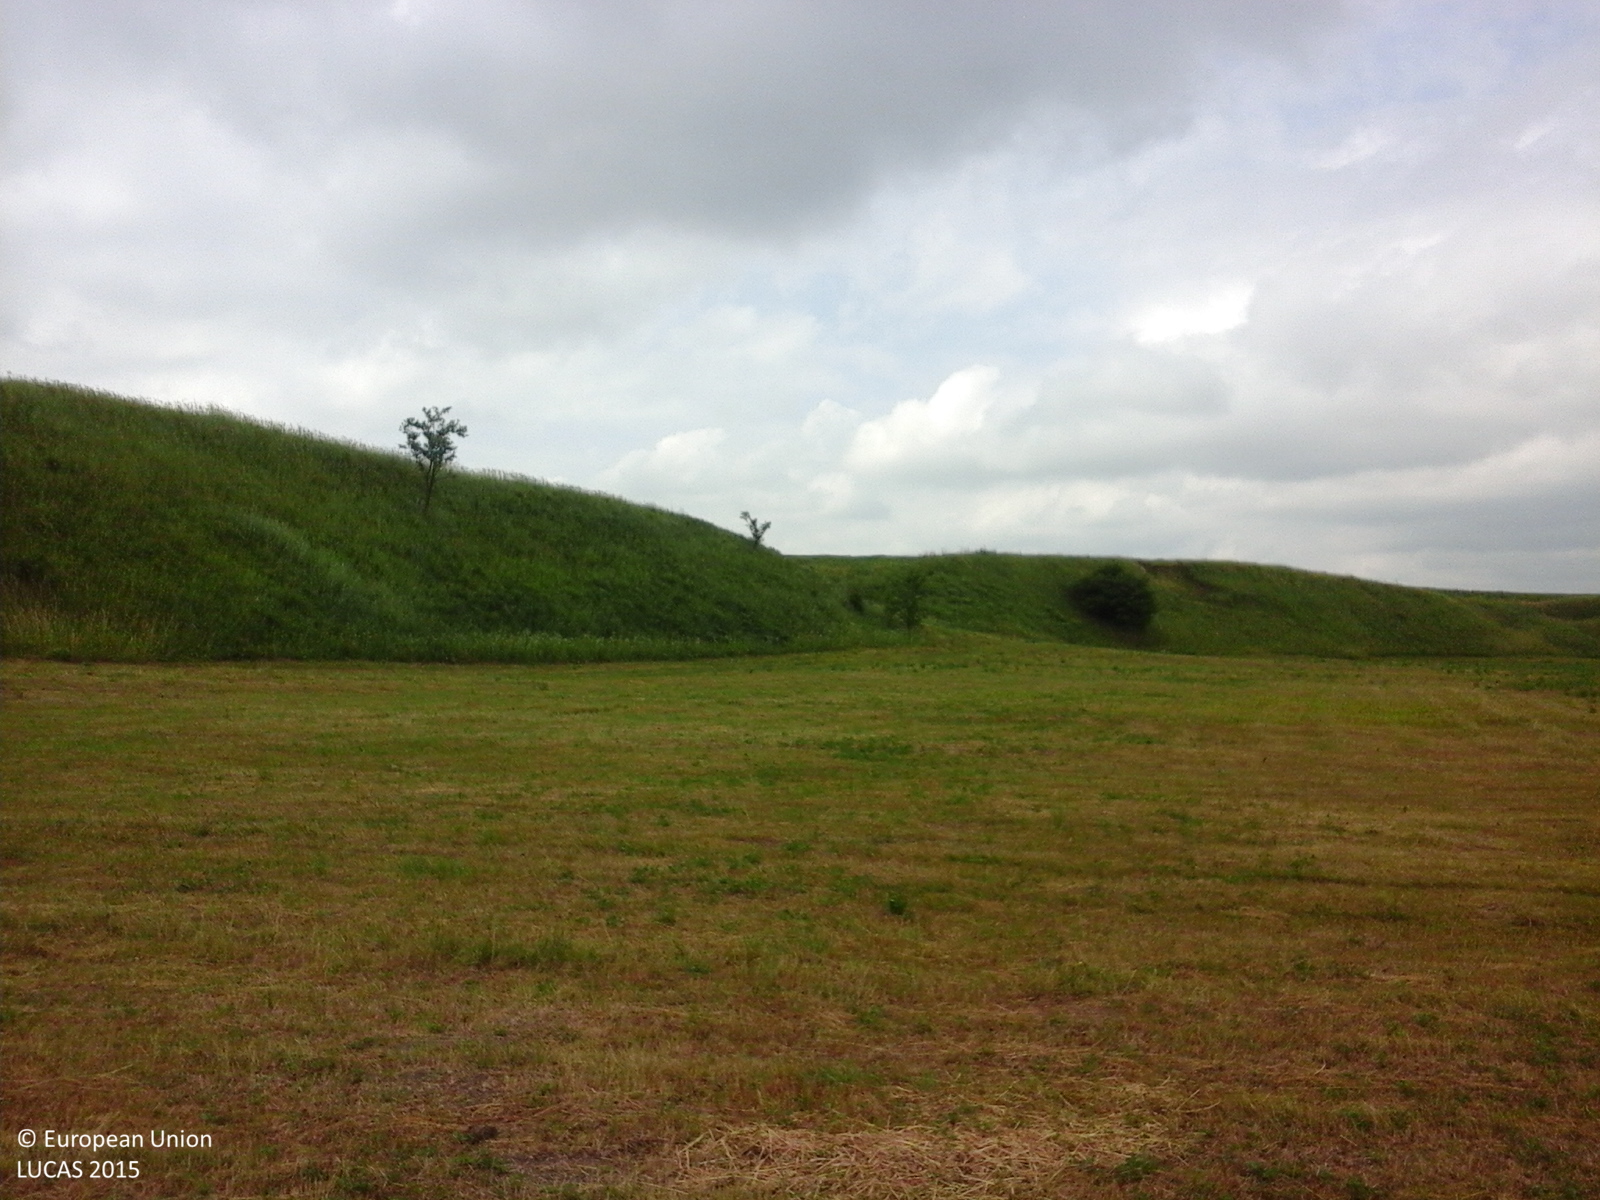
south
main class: Cropland
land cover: Other leguminous and mixtures for fodder
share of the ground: > 75 %
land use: Agriculture (excluding fallow land and kitchen gardens)
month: June
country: RO
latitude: 47.3627
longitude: 26.6838
